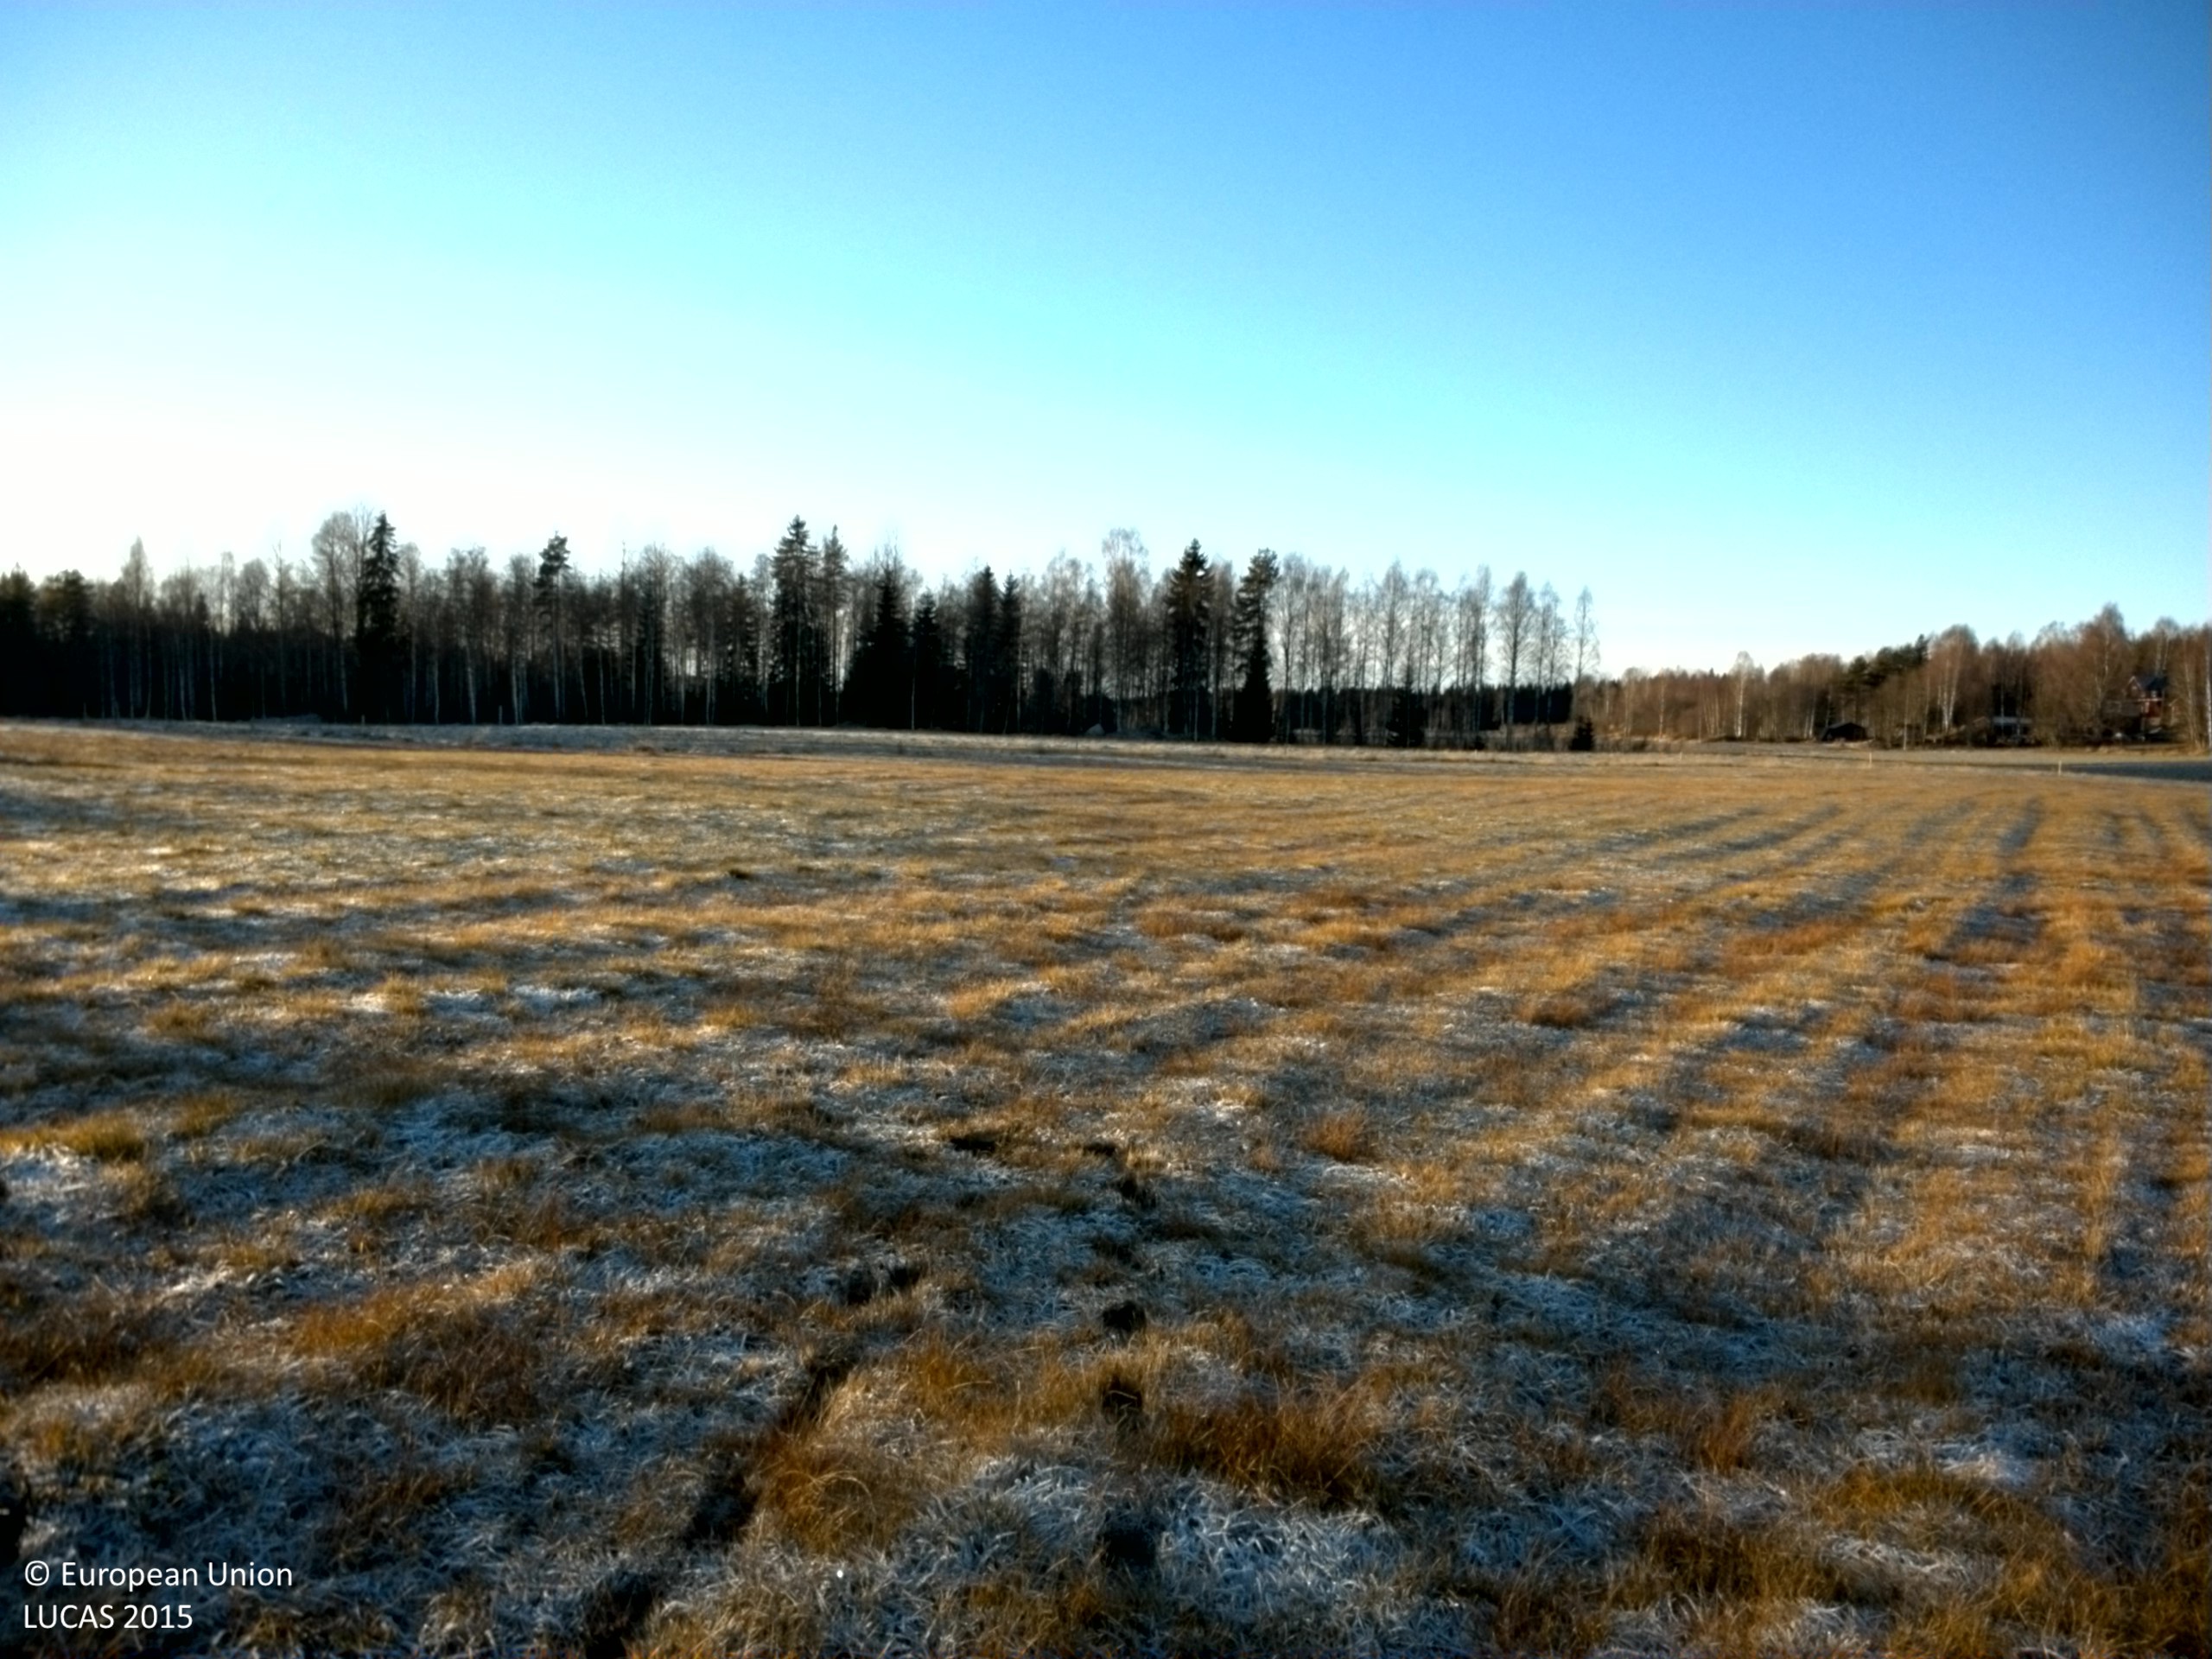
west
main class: Cropland
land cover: Mixed cereals for fodder
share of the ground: > 75 %
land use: Agriculture (excluding fallow land and kitchen gardens)
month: November
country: SE
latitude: 61.8159
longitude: 16.1887
